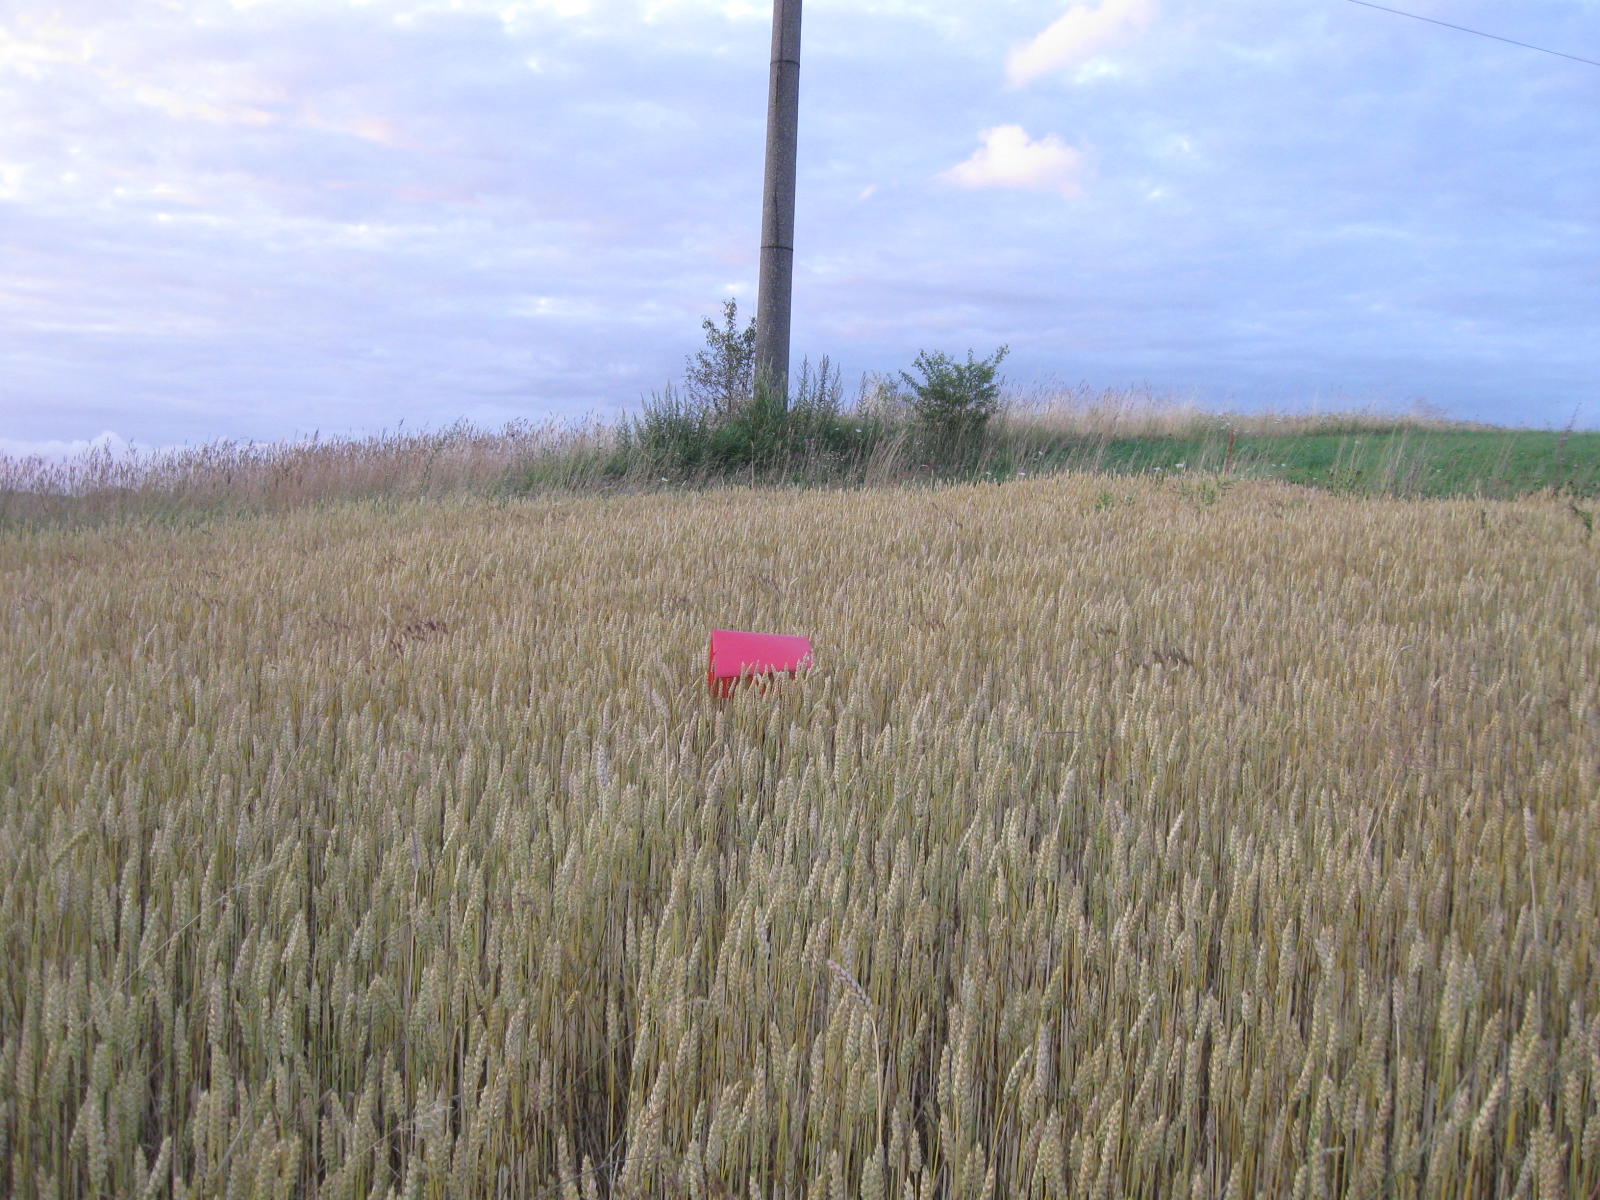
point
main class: Cropland
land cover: Common wheat
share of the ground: > 75 %
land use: Agriculture (excluding fallow land and kitchen gardens)
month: July
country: LT
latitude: 54.3707
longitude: 24.3380
